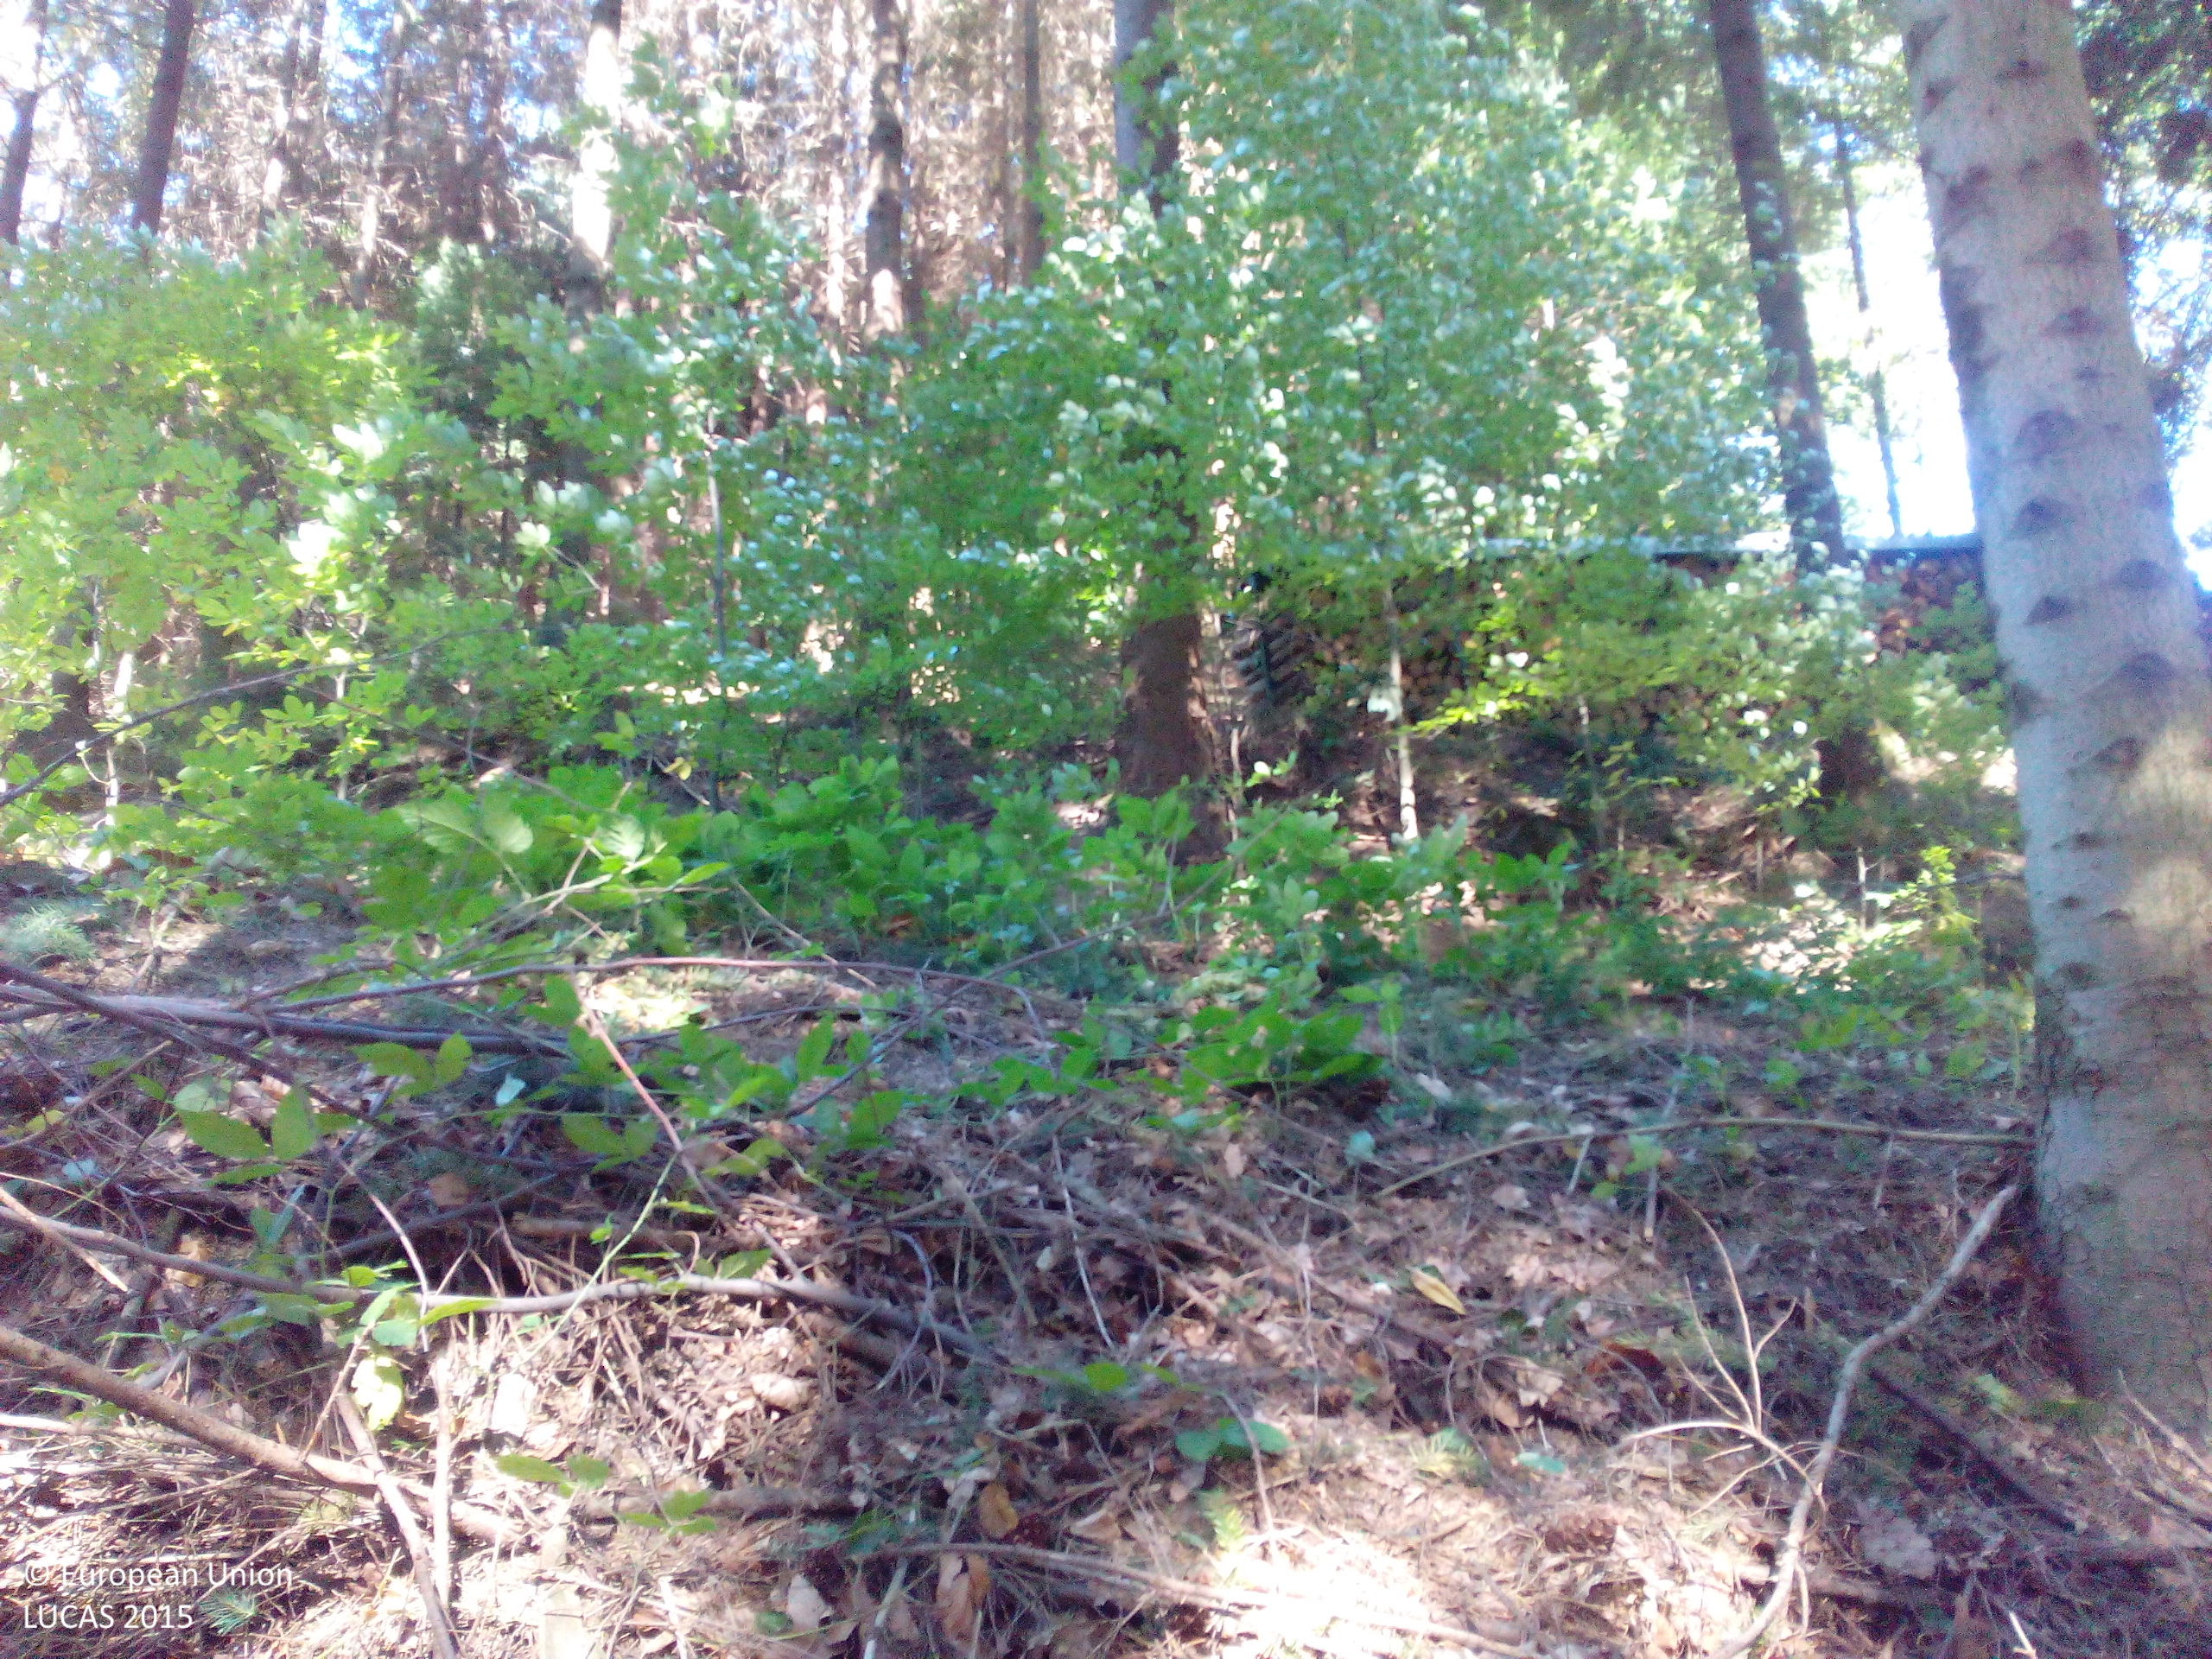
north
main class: Woodland
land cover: Spruce dominated coniferous woodland
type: hemiboreal forest and nemoral coniferous forest and mixed broadleaved-coniferous forest
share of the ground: > 75 %
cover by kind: coniferous forest trees 95 %, shrubs 5 %
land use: Forestry
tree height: > 5 m
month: September
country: DE
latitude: 48.5504
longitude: 8.1719
